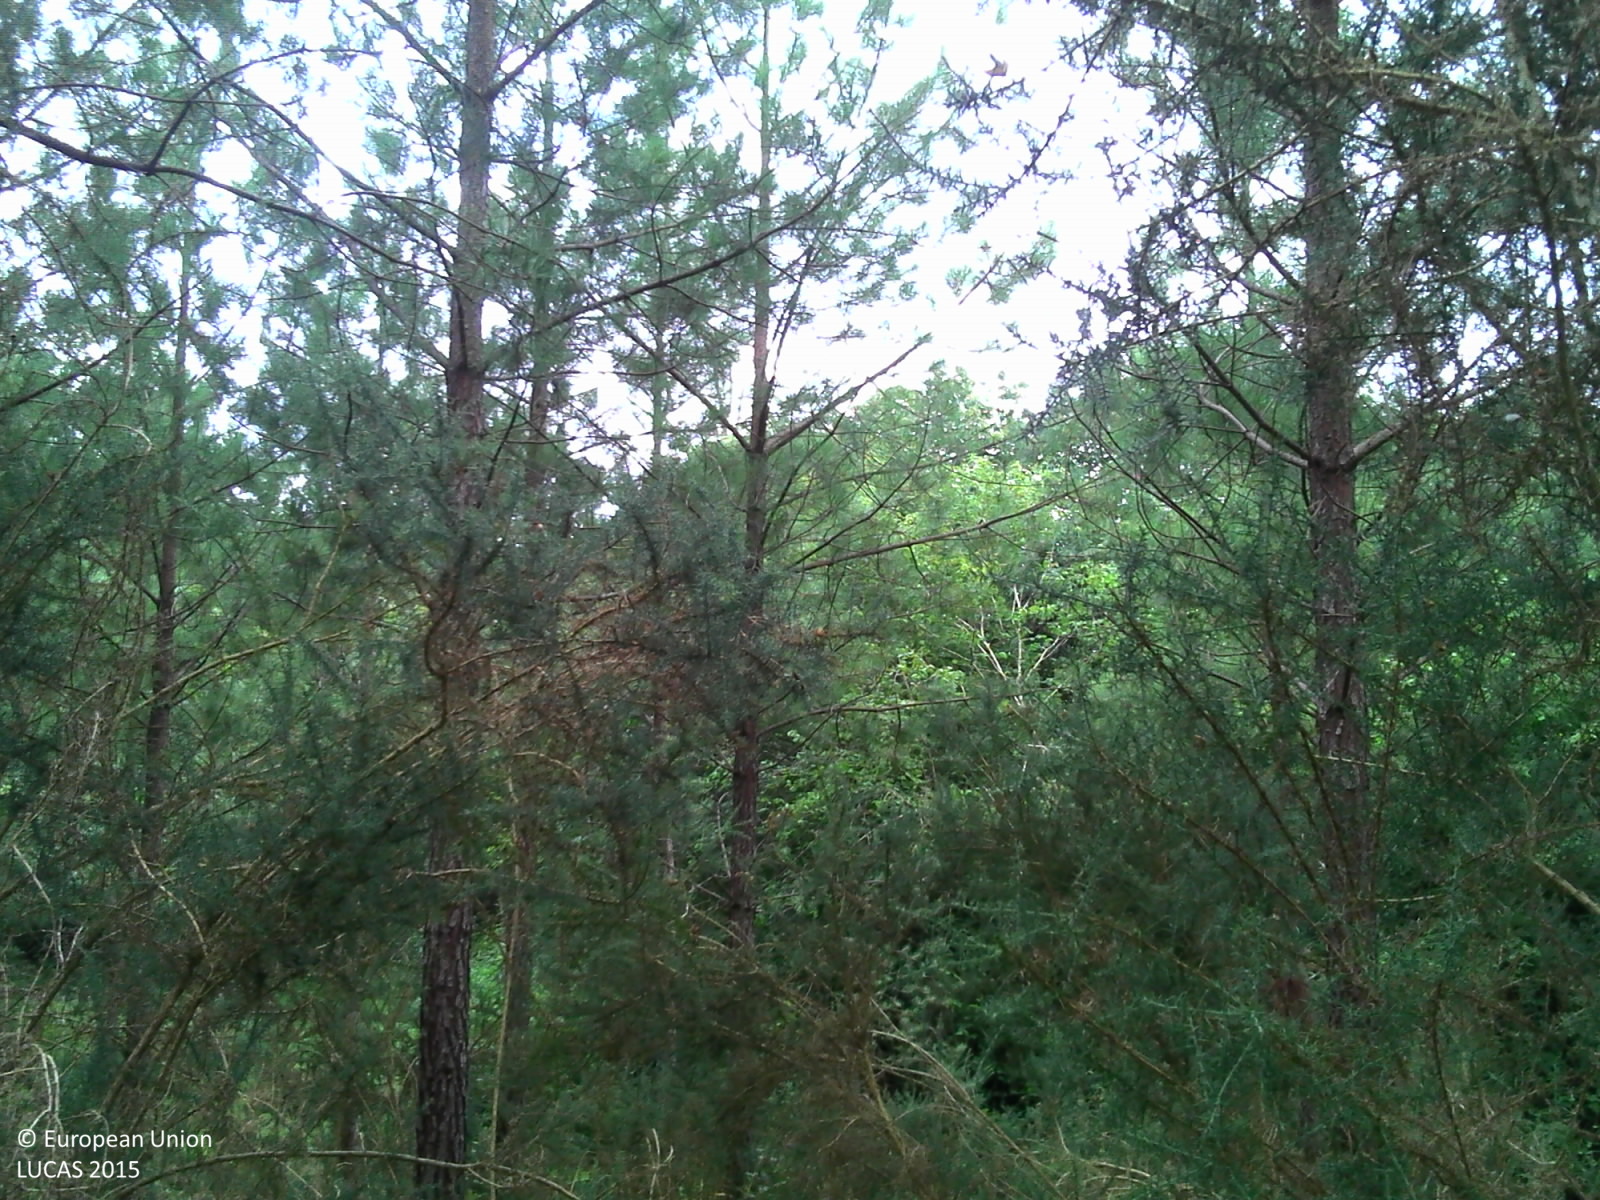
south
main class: Woodland
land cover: Pine dominated coniferous woodland
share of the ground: > 75 %
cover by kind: coniferous forest trees 85 %, herbaceous plants 10 %, broadleaved forest trees 5 %
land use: Forestry
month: July
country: FR
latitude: 43.5911
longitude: -1.2510
